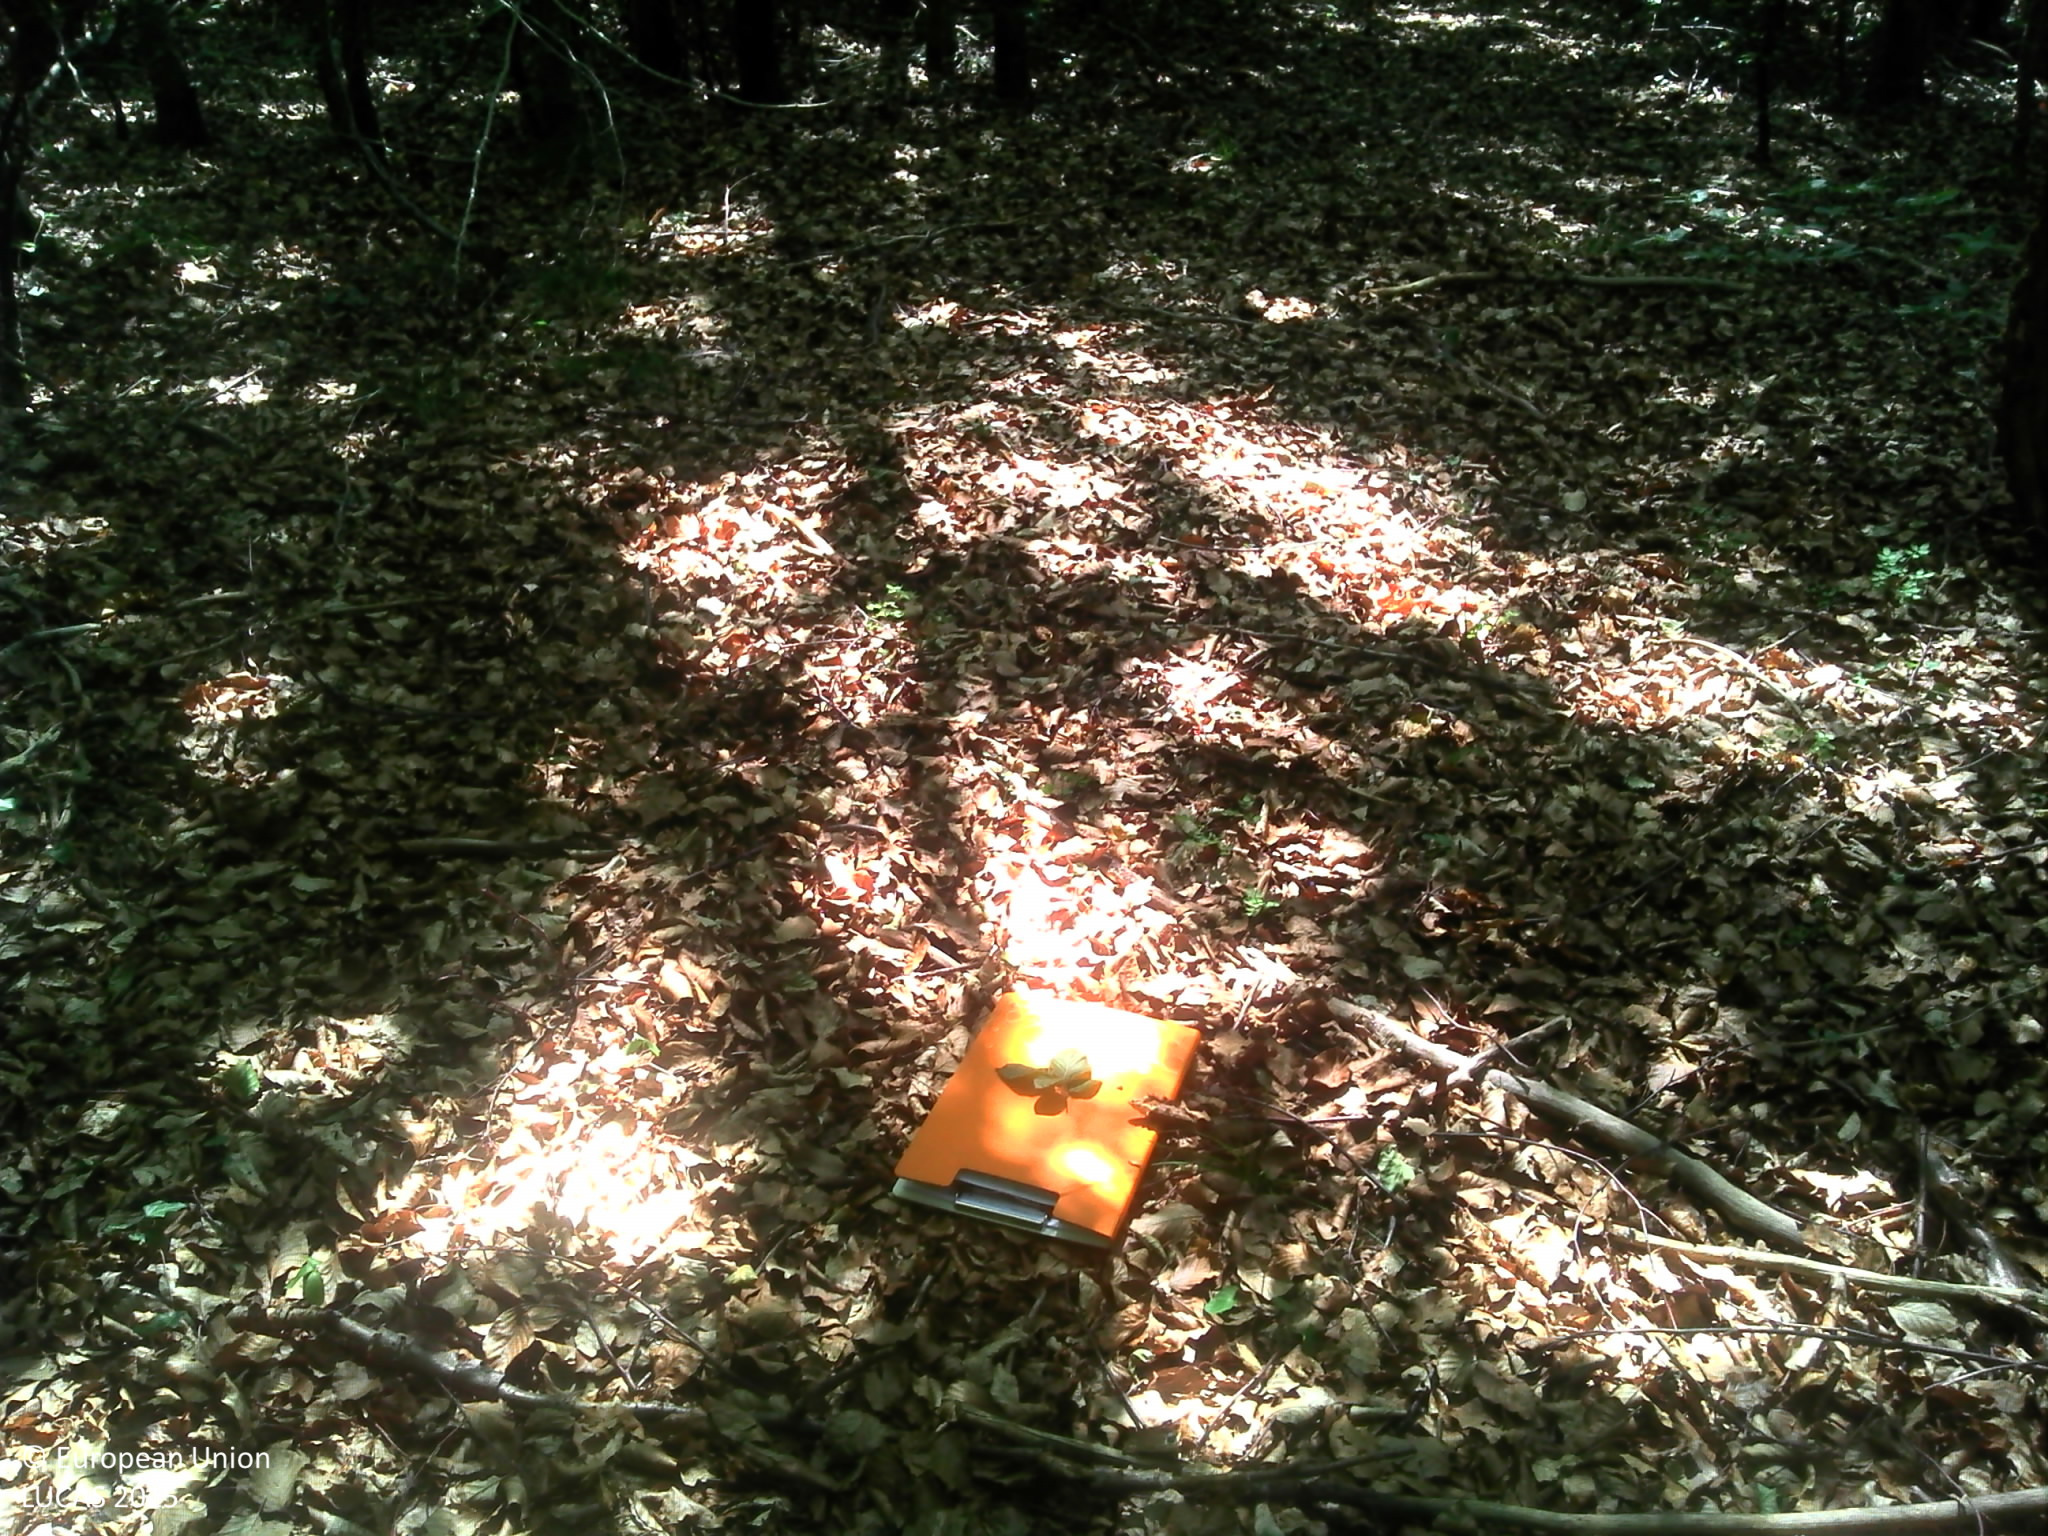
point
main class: Woodland
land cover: Broadleaved woodland
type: beech forest
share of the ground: > 75 %
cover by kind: broadleaved forest trees 95 %, lichens and mosses 5 %
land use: Forestry
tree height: > 5 m
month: July
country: FR
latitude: 47.9661
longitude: 5.0033
